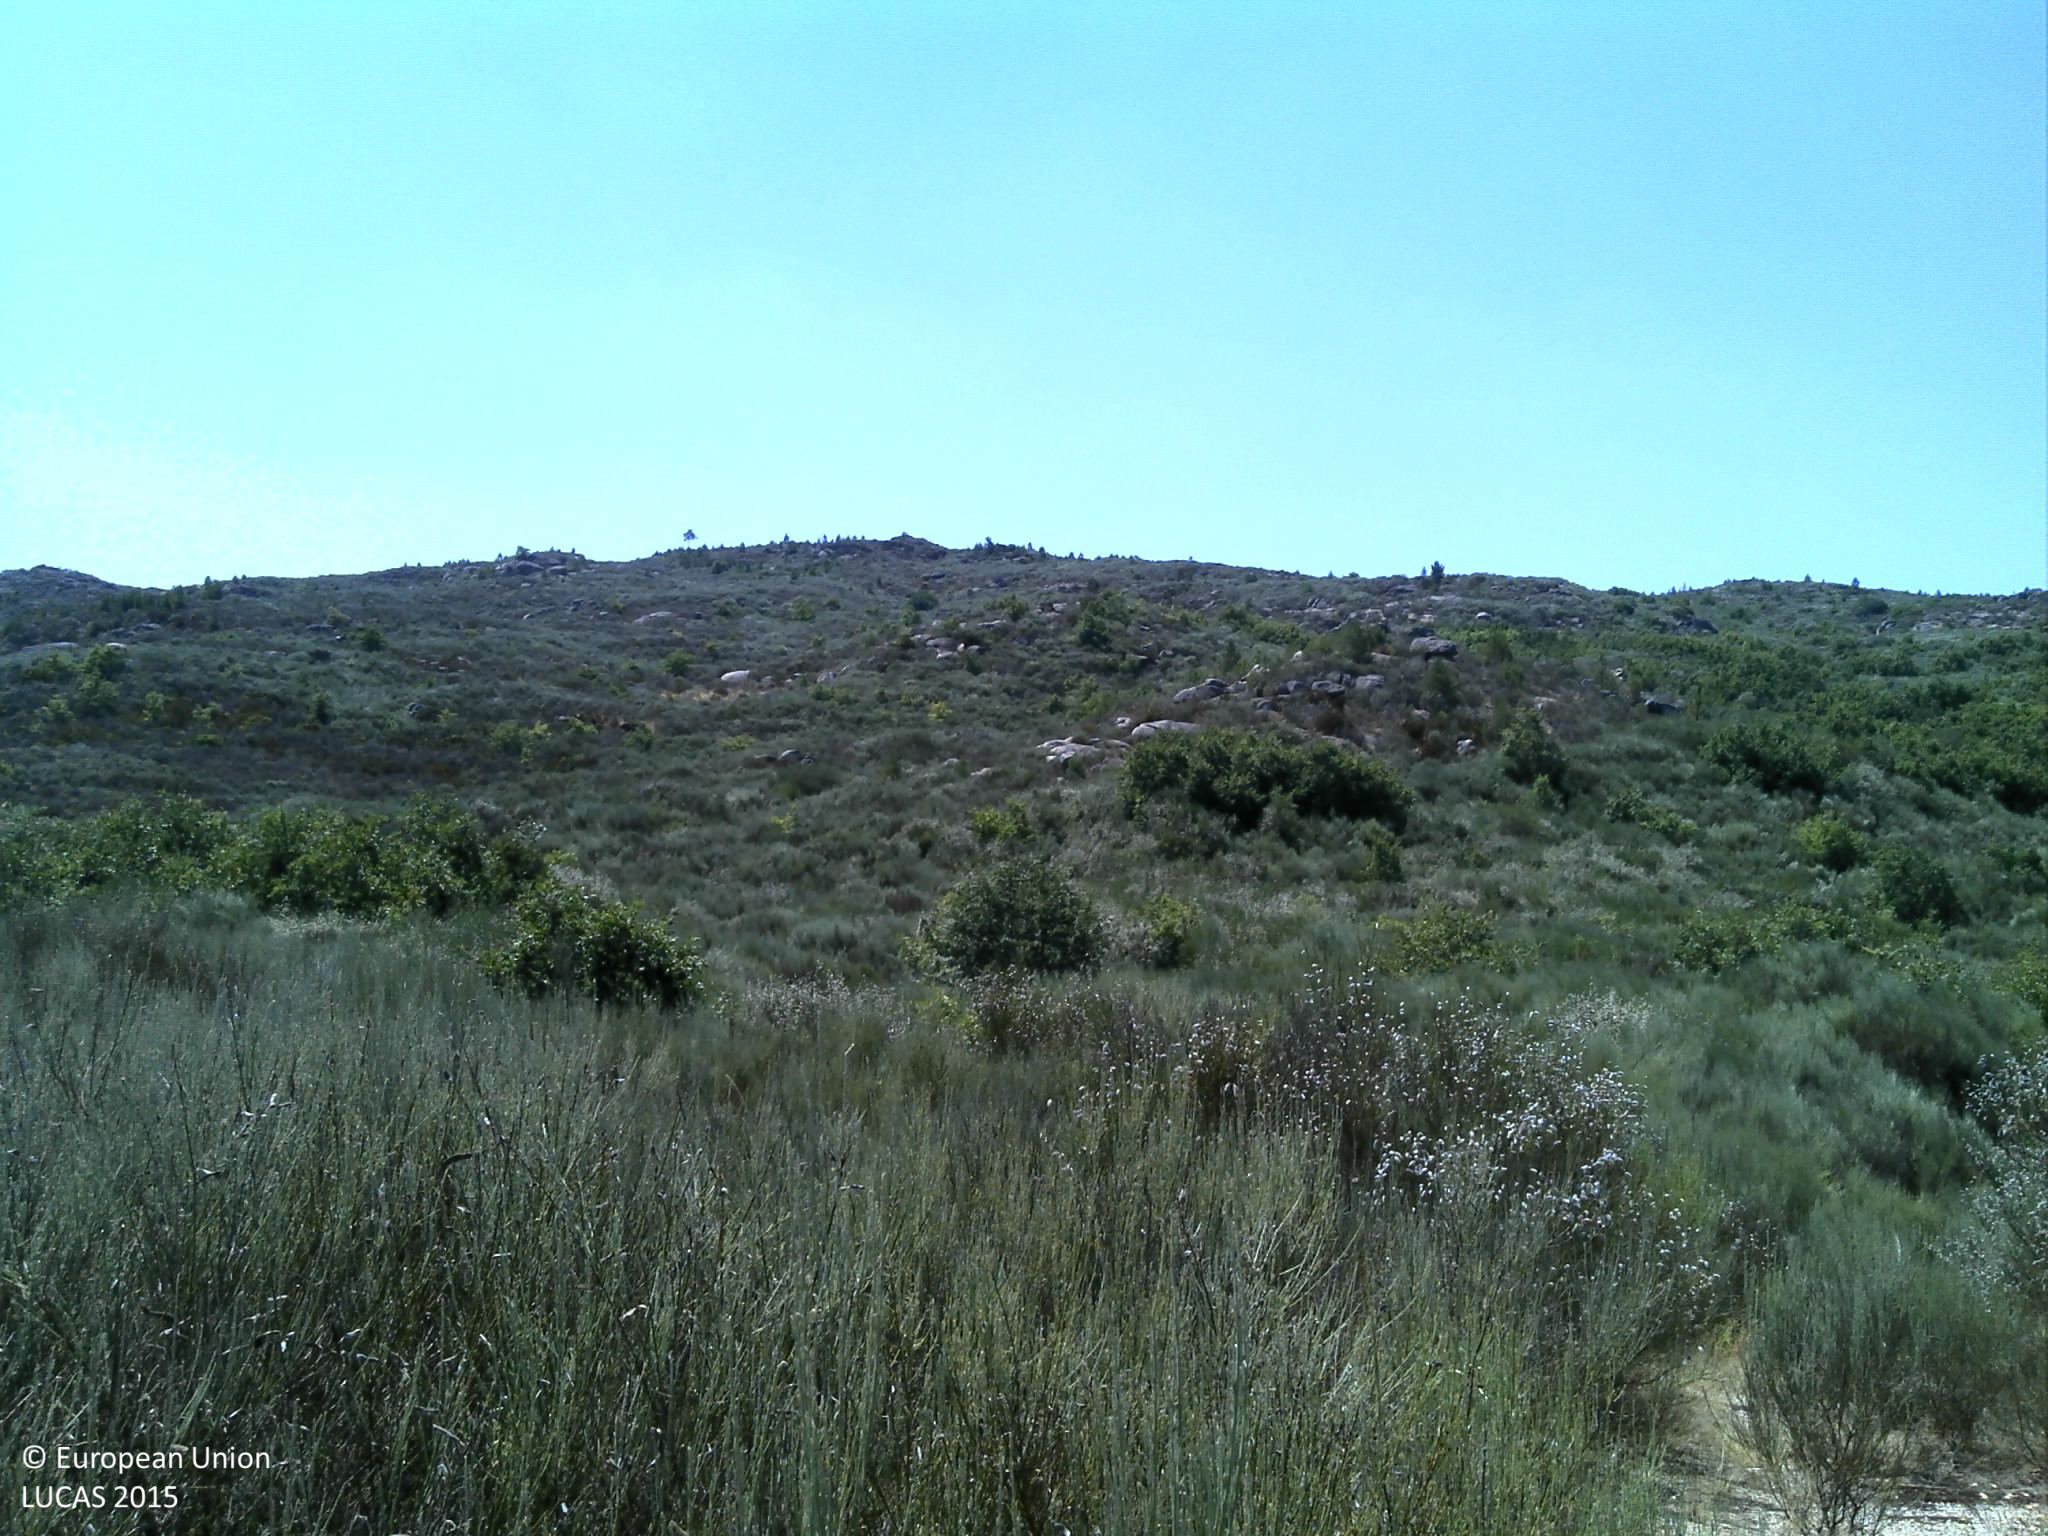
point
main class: Shrubland
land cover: Shrubland without tree cover
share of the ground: > 75 %
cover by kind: shrubs 90 %, herbaceous plants 5 %, consolidated bare surface 5 %
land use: Semi-natural and natural areas not in use
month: July
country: PT
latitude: 40.8455
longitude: -7.4683
